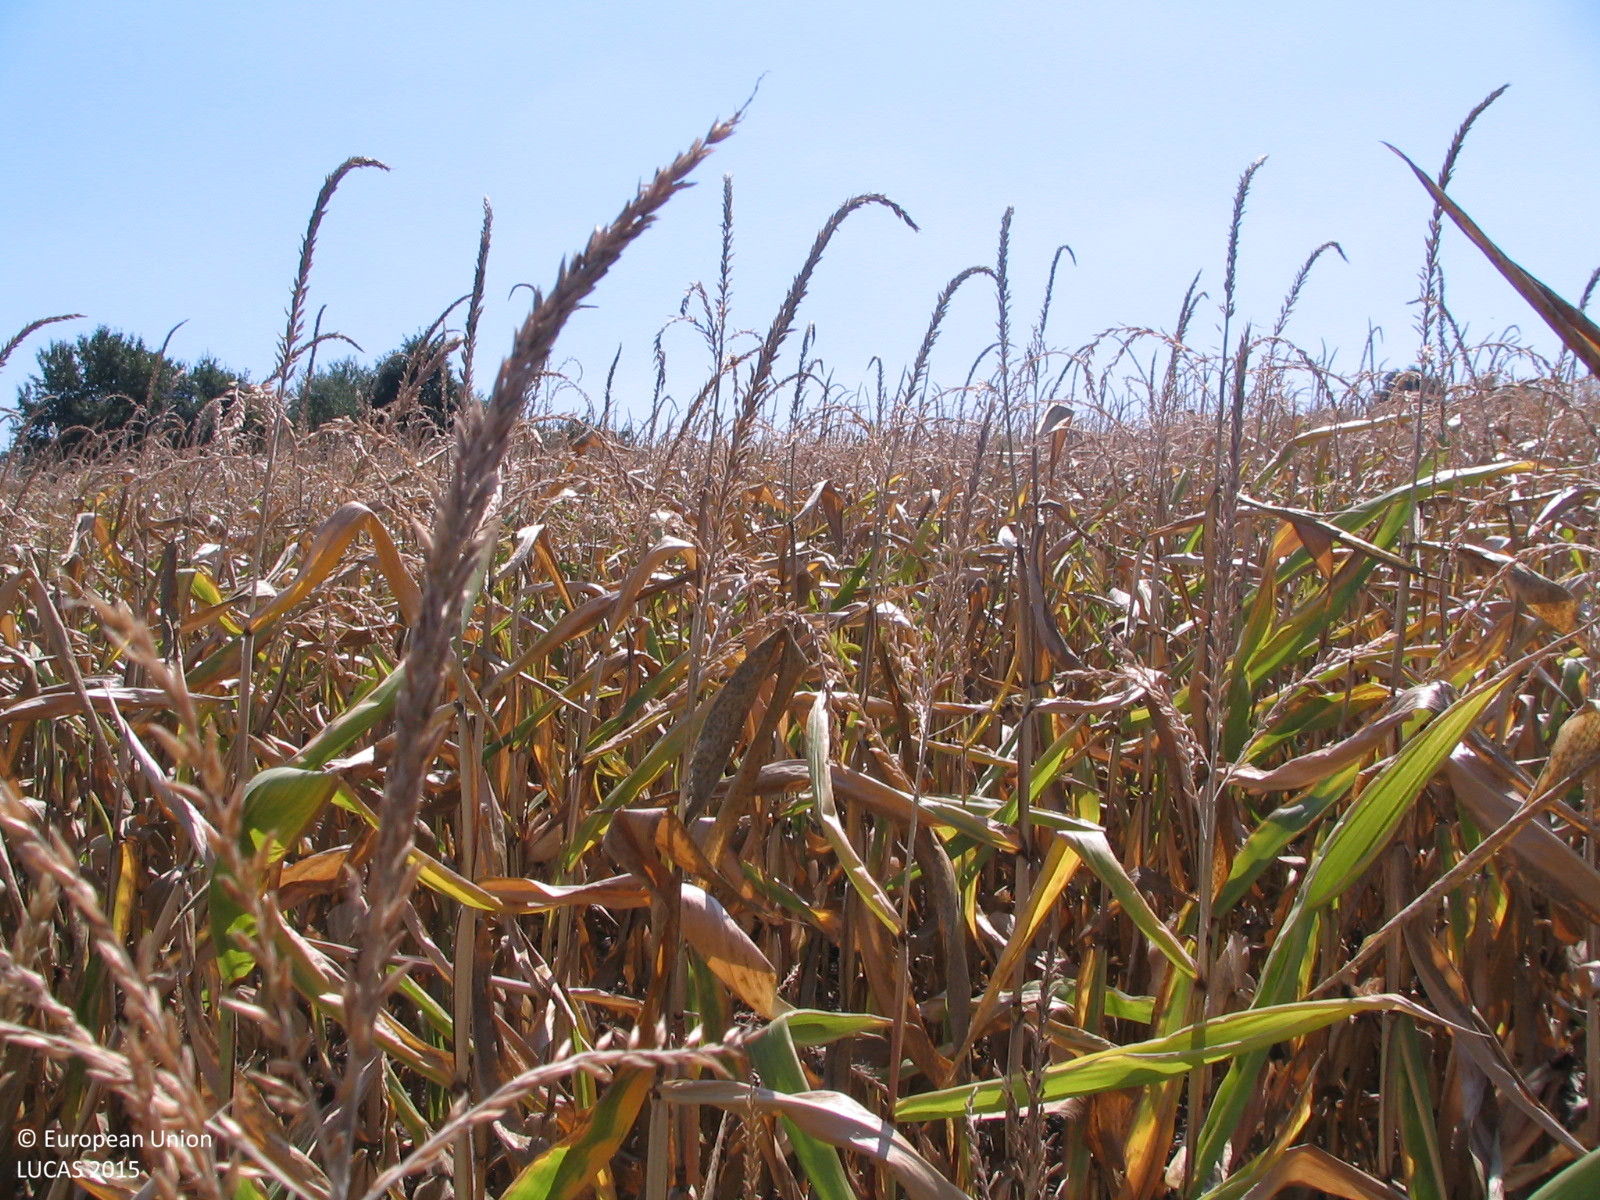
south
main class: Cropland
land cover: Maize
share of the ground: > 75 %
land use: Agriculture (excluding fallow land and kitchen gardens)
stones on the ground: < 10 %
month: August
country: BG
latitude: 43.1878
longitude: 24.4411
